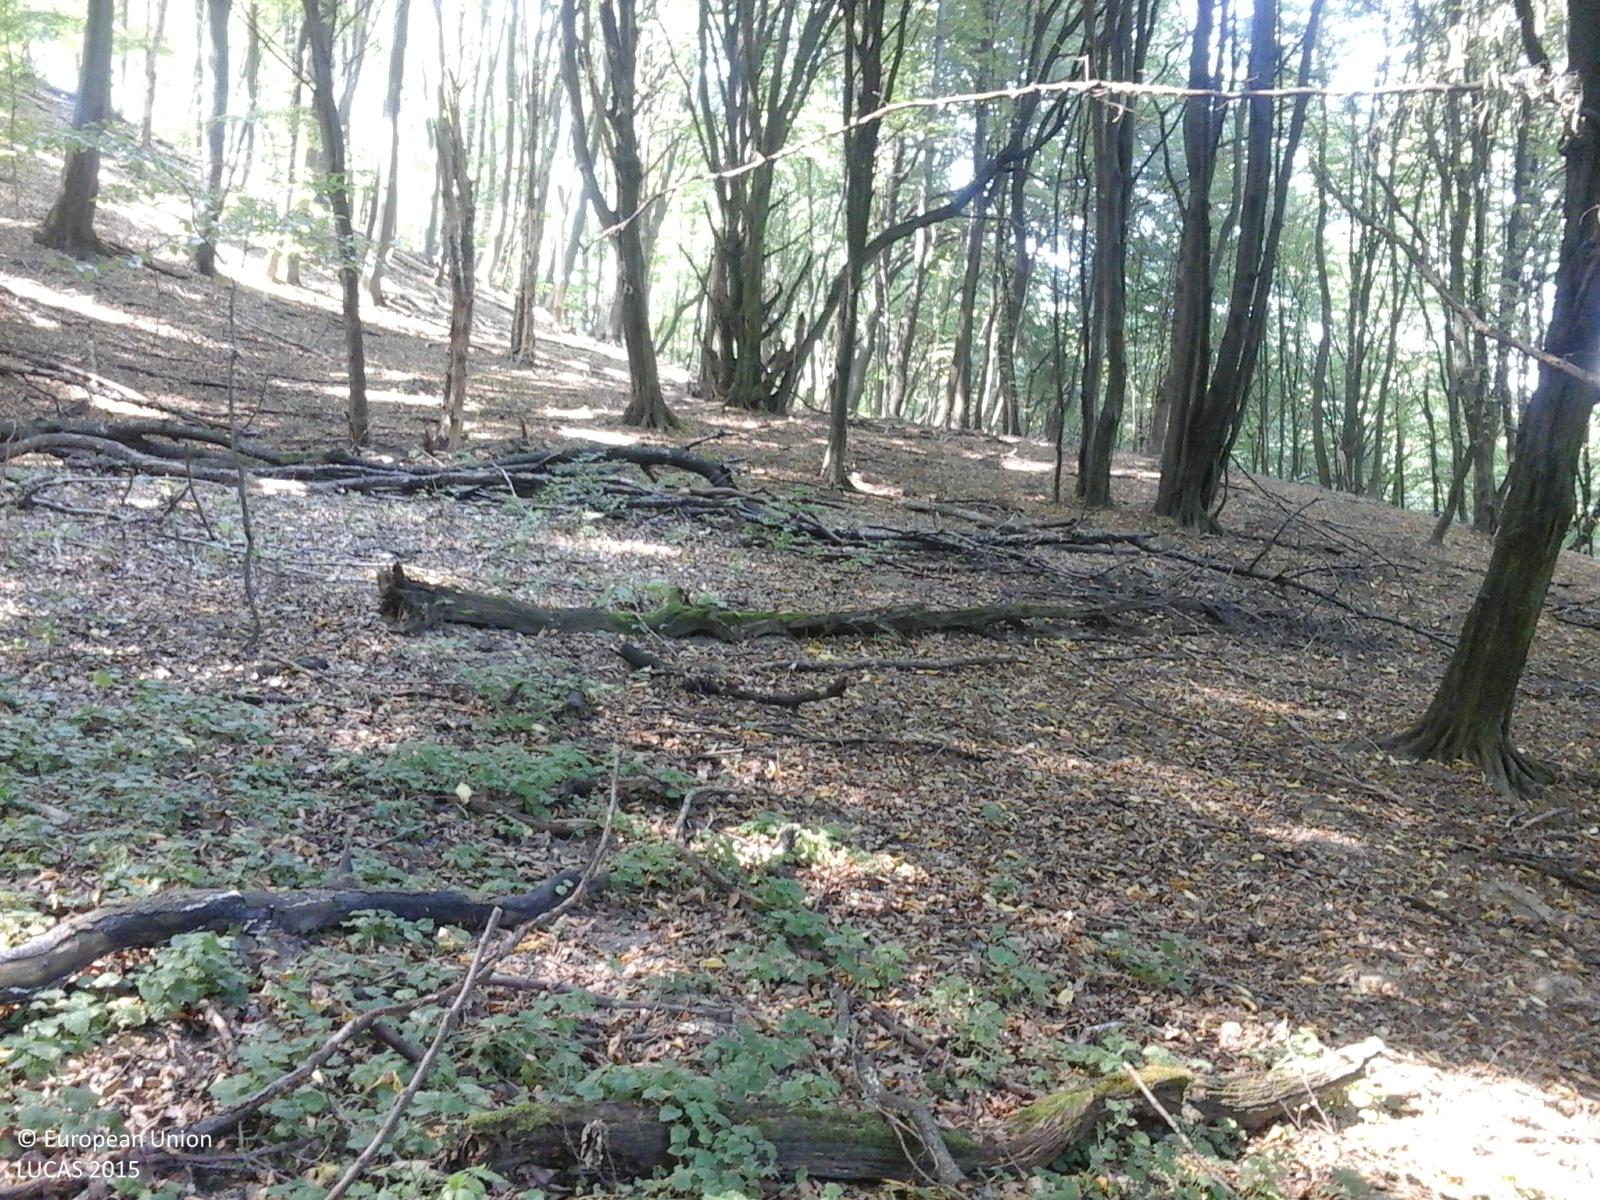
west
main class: Woodland
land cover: Broadleaved woodland
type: beech forest
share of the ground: > 75 %
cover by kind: broadleaved forest trees 100 %
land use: Forestry
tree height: > 5 m
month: August
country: RO
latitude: 45.9010
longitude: 22.6954
